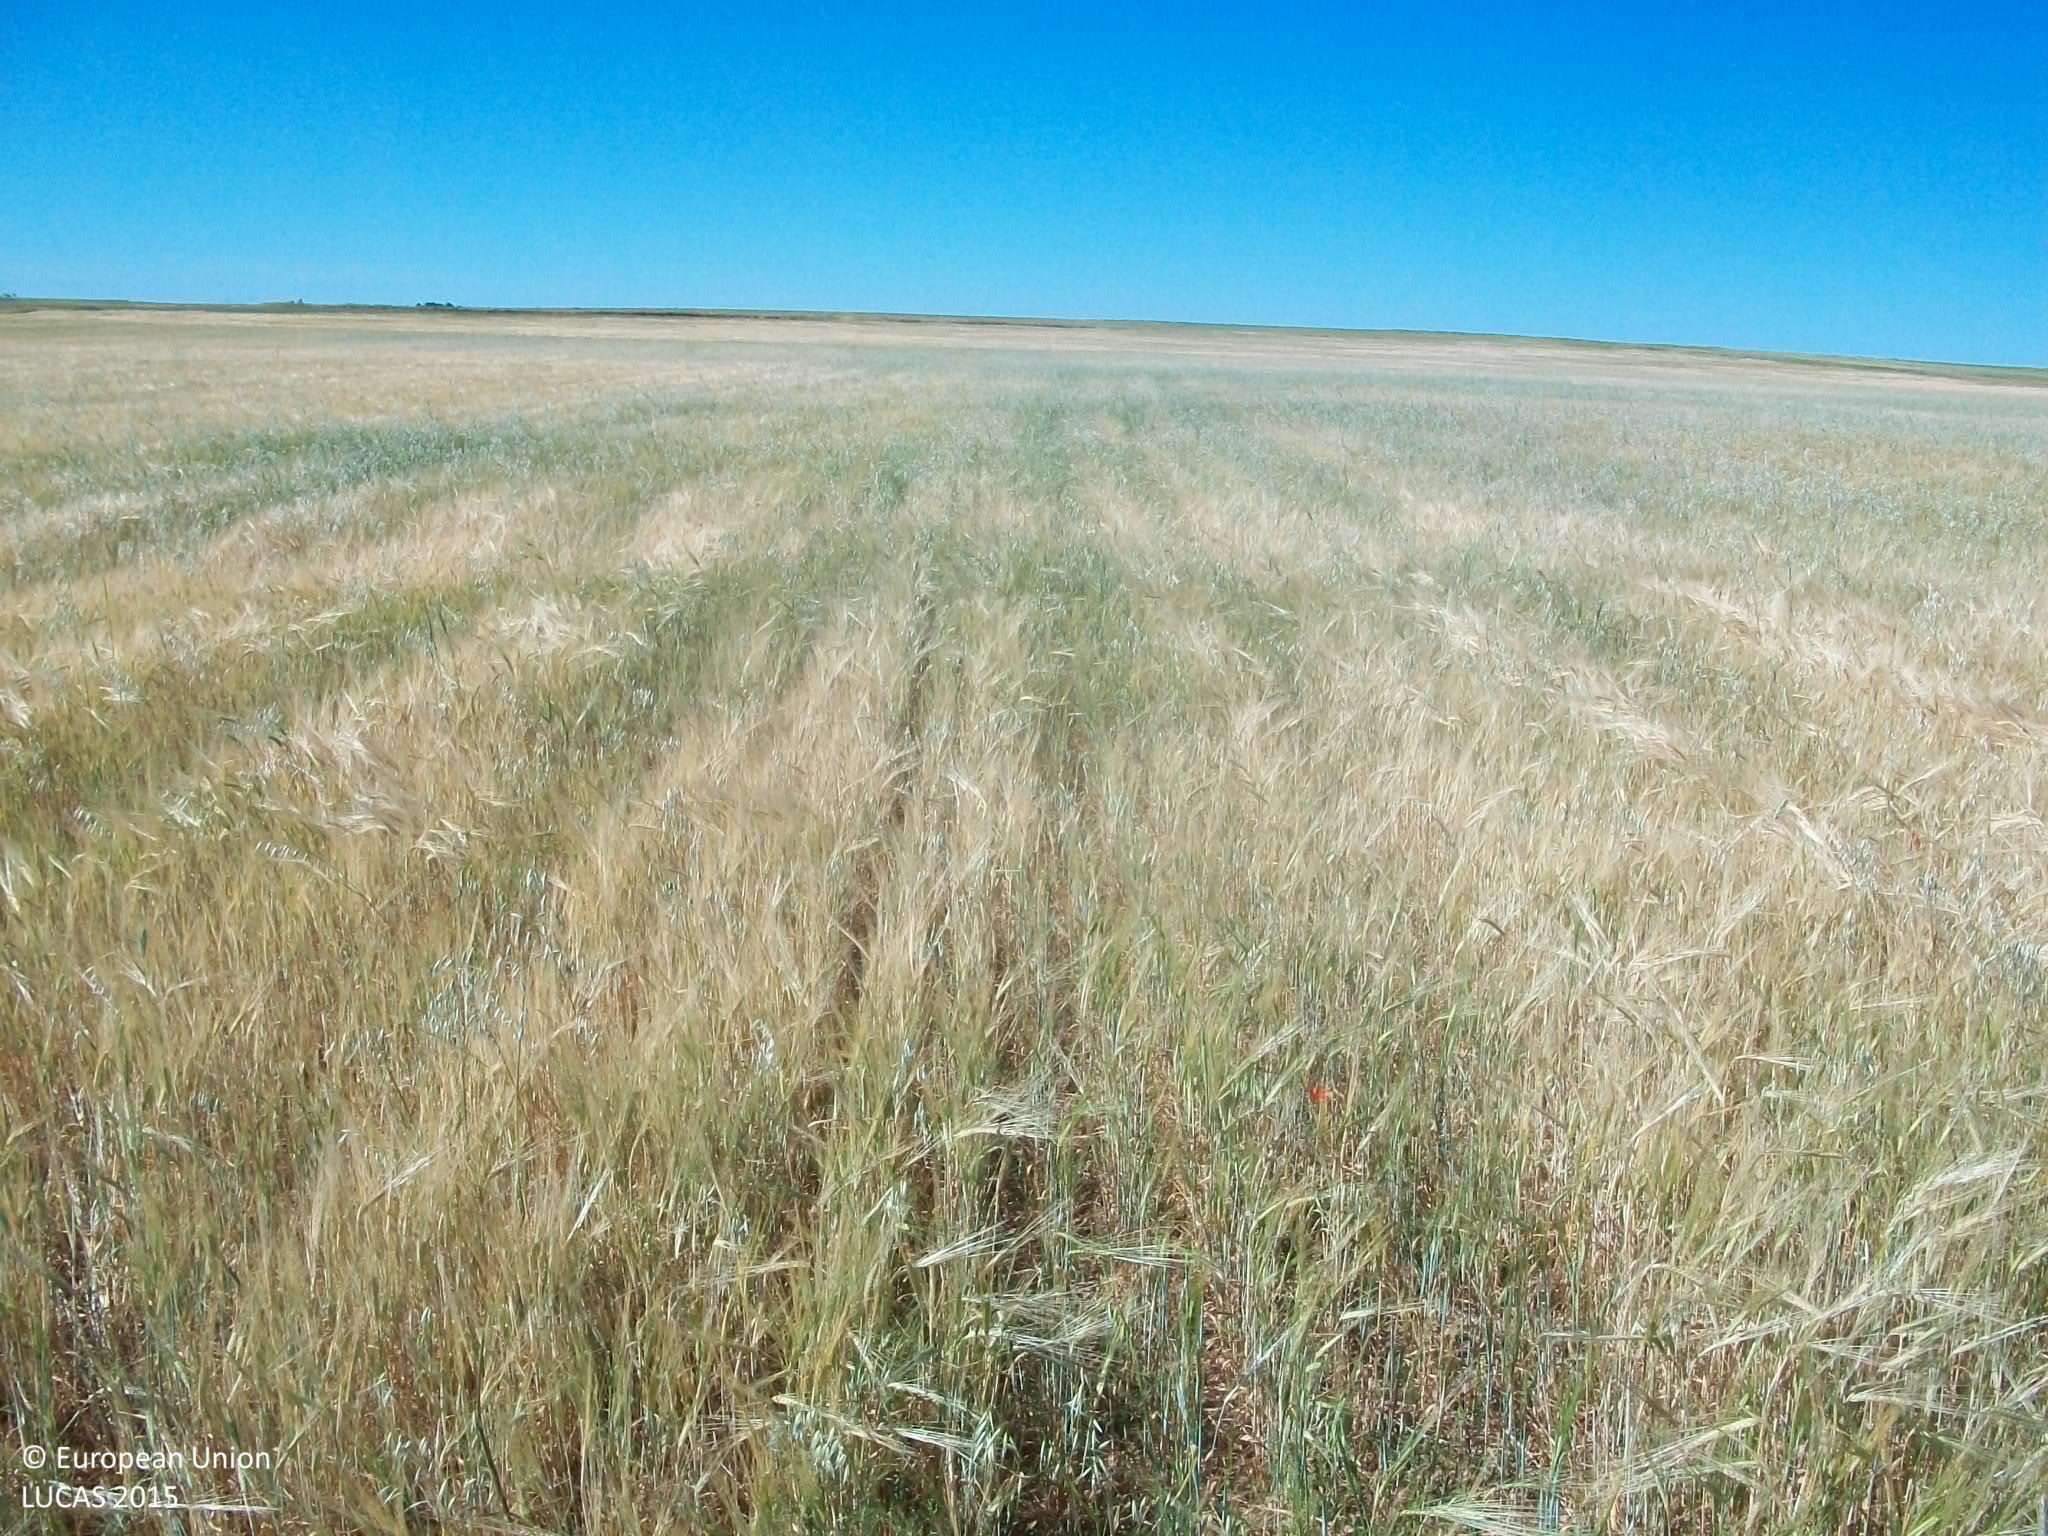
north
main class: Cropland
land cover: Barley
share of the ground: > 75 %
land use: Agriculture (excluding fallow land and kitchen gardens)
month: May
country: ES
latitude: 39.7774
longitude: -3.4409
